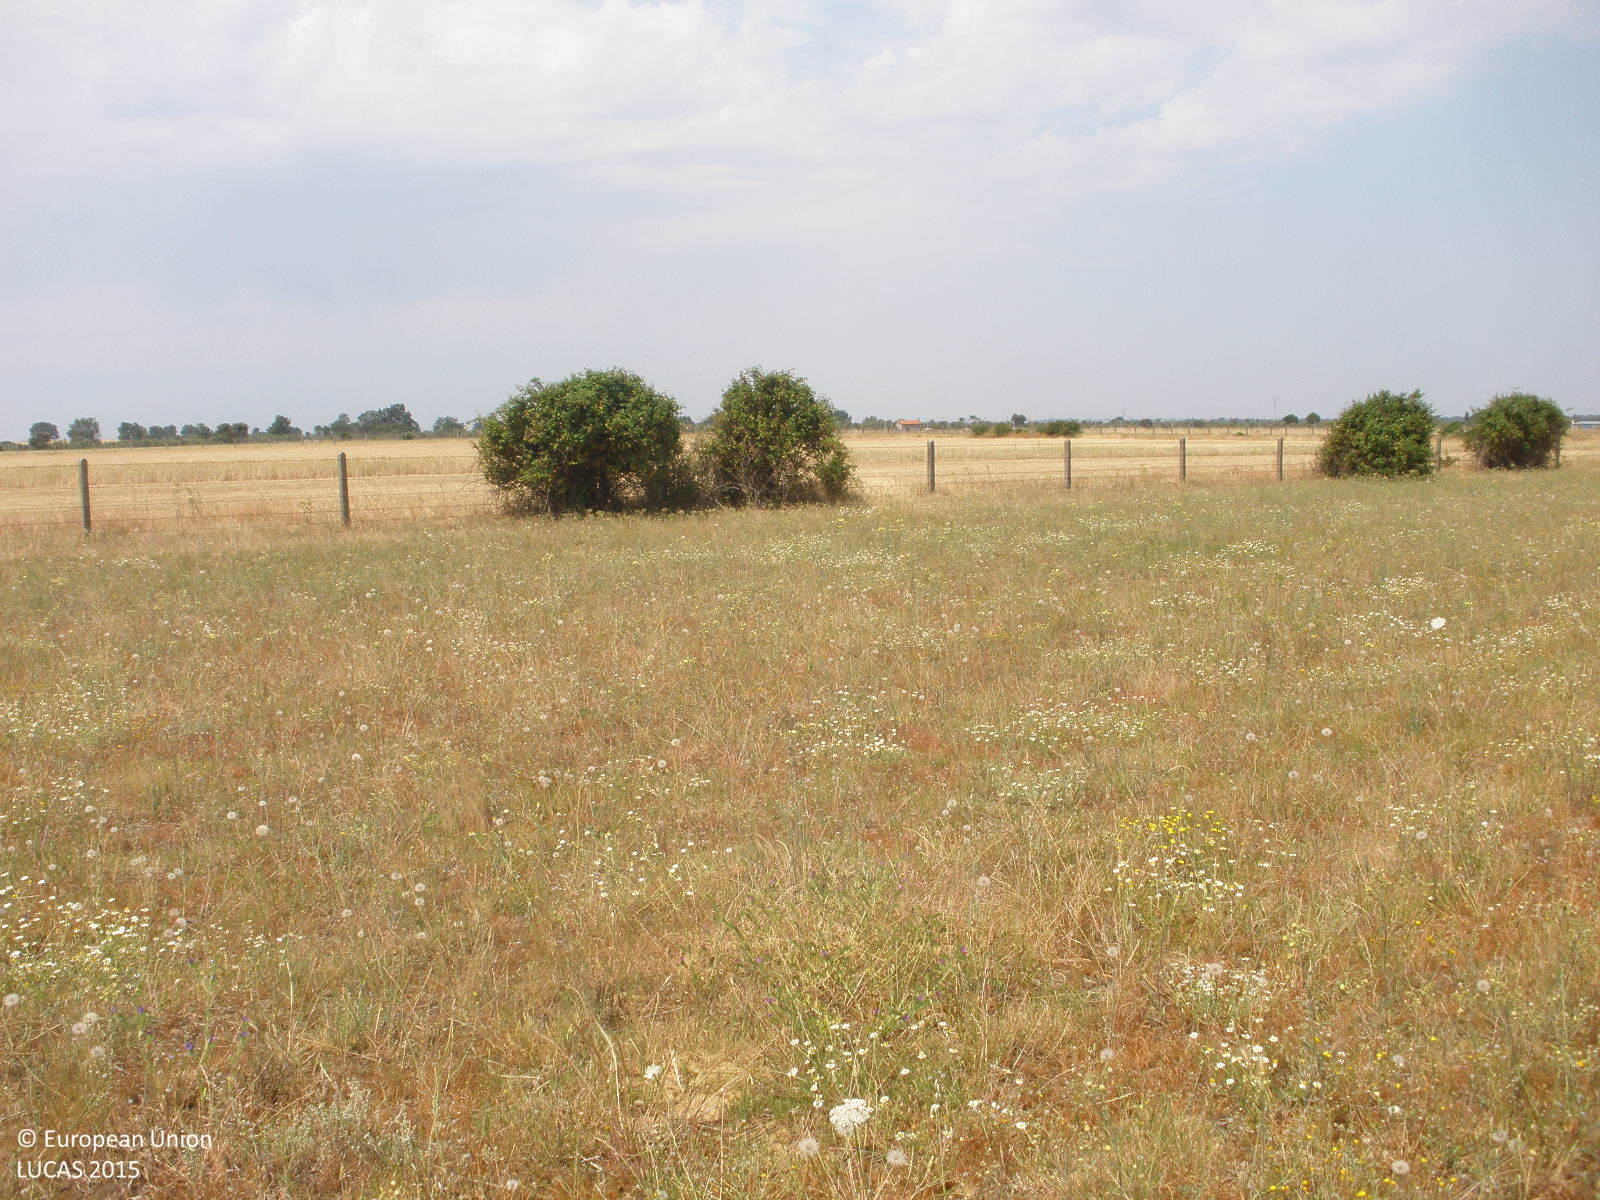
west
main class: Grassland
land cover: Grassland without tree/shrub cover
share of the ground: > 75 %
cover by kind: herbaceous plants 100 %
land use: Agriculture (excluding fallow land and kitchen gardens)
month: June
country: ES
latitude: 40.6392
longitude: -6.3205
